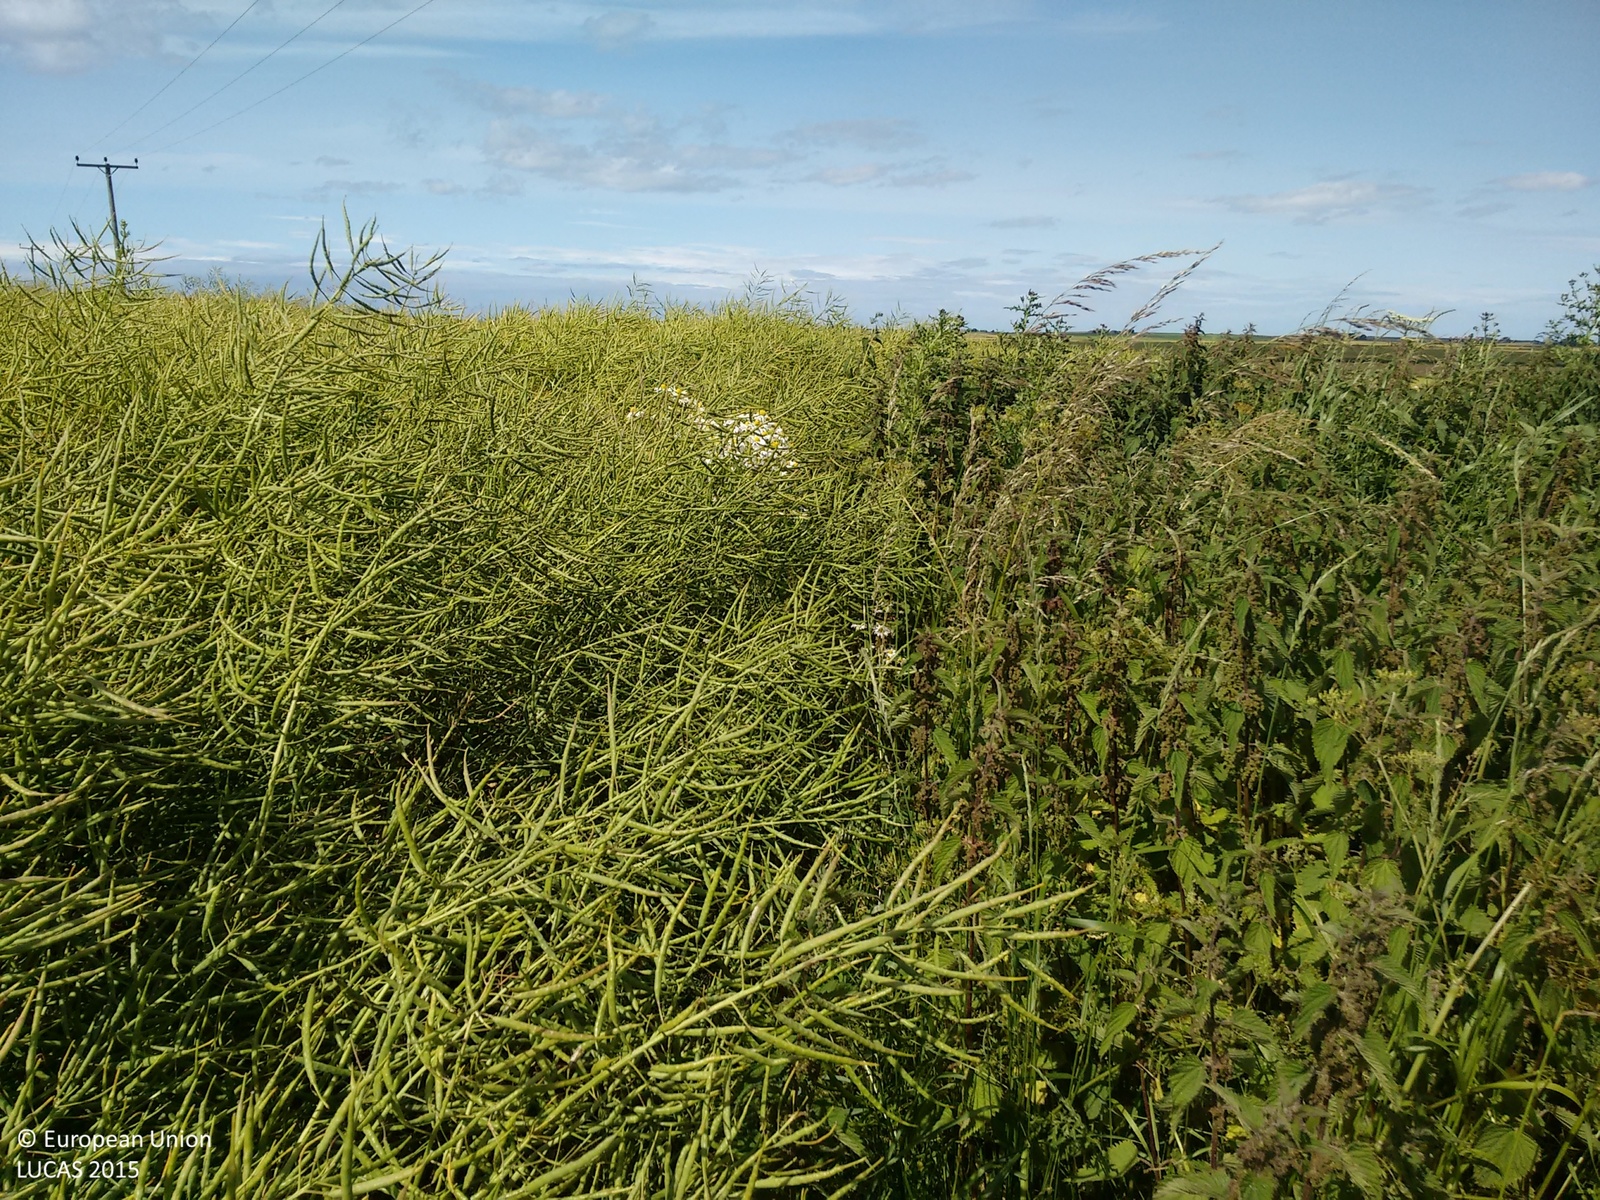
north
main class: Cropland
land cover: Rape and turnip rape
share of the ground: > 75 %
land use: Agriculture (excluding fallow land and kitchen gardens)
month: July
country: GB
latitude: 57.6527
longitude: -2.0942
